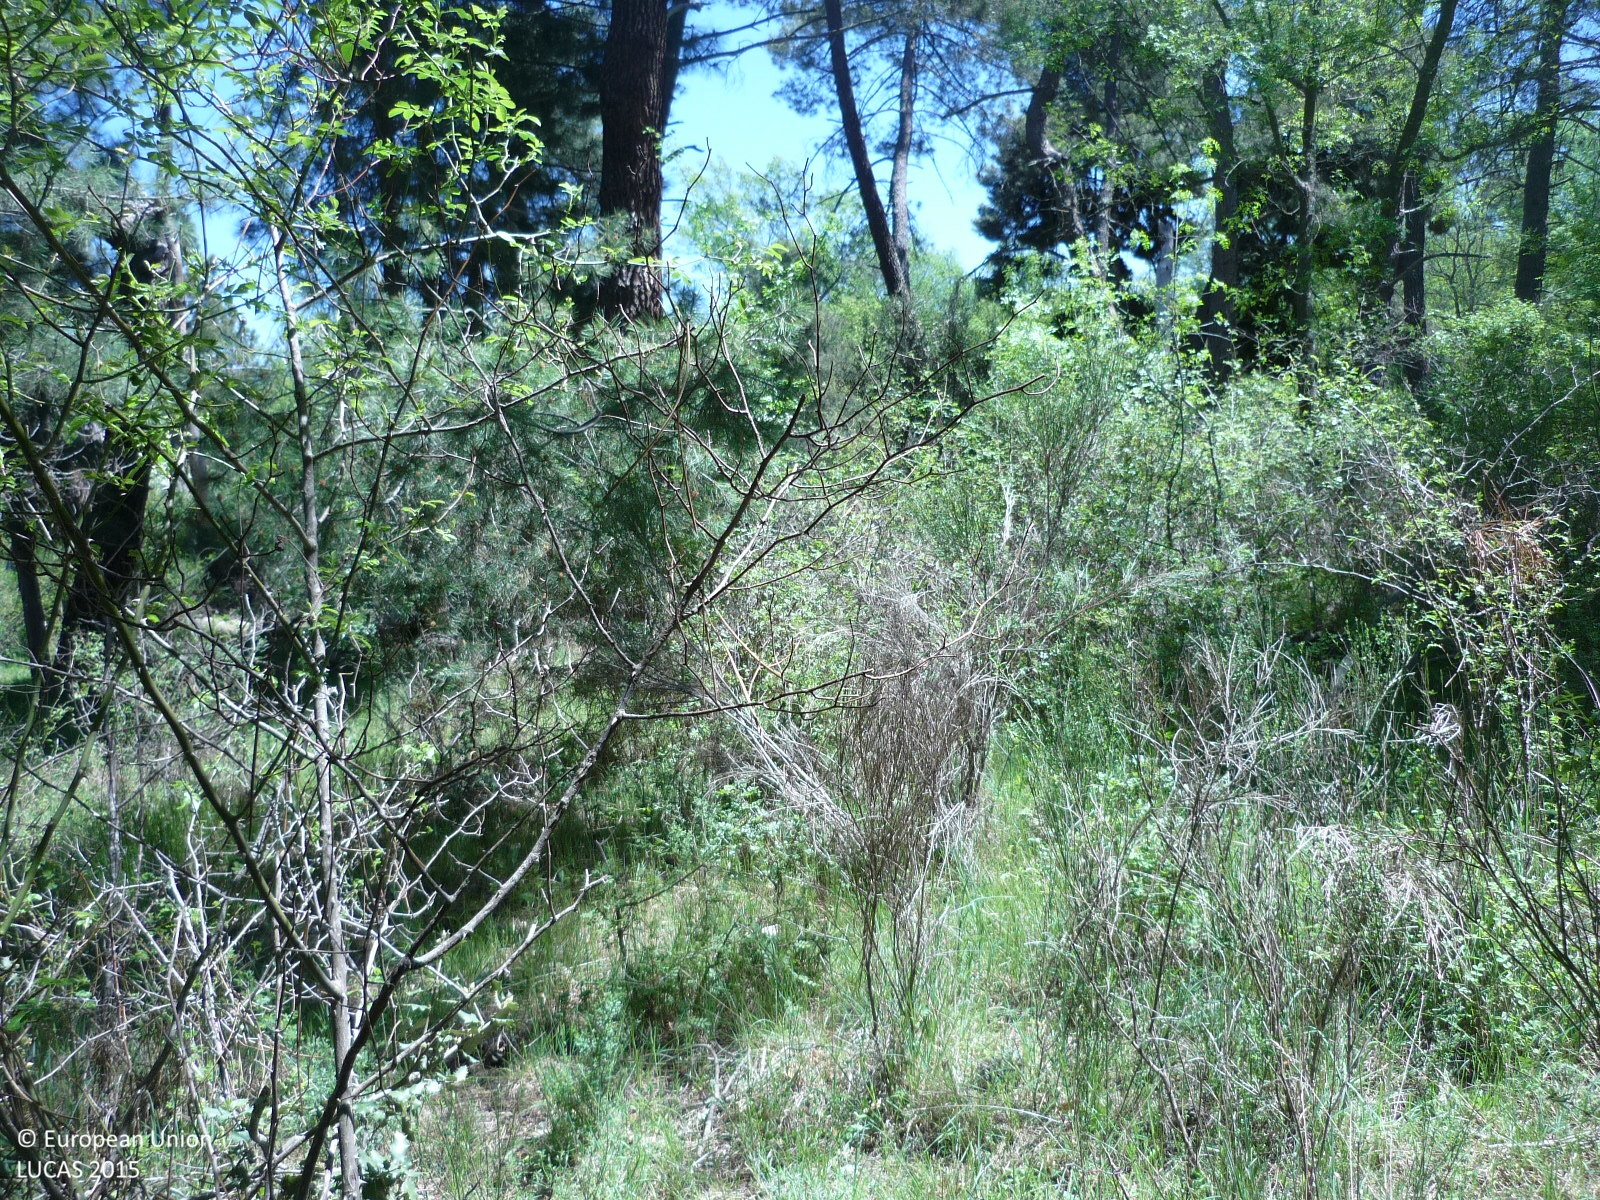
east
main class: Woodland
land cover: Broadleaved woodland
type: thermophilous deciduous forest
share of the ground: > 75 %
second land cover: Grassland without tree/shrub cover
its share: > 75 %
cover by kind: broadleaved forest trees 90 %, herbaceous plants 10 %
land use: Forestry
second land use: Agriculture (excluding fallow land and kitchen gardens)
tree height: < 5 m
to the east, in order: Broadleaved woodland; Grassland without tree/shrub cover; Pine dominated coniferous woodland; Dry stone walls; Pine dominated coniferous woodland
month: May
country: ES
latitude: 40.9812
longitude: -3.6042
